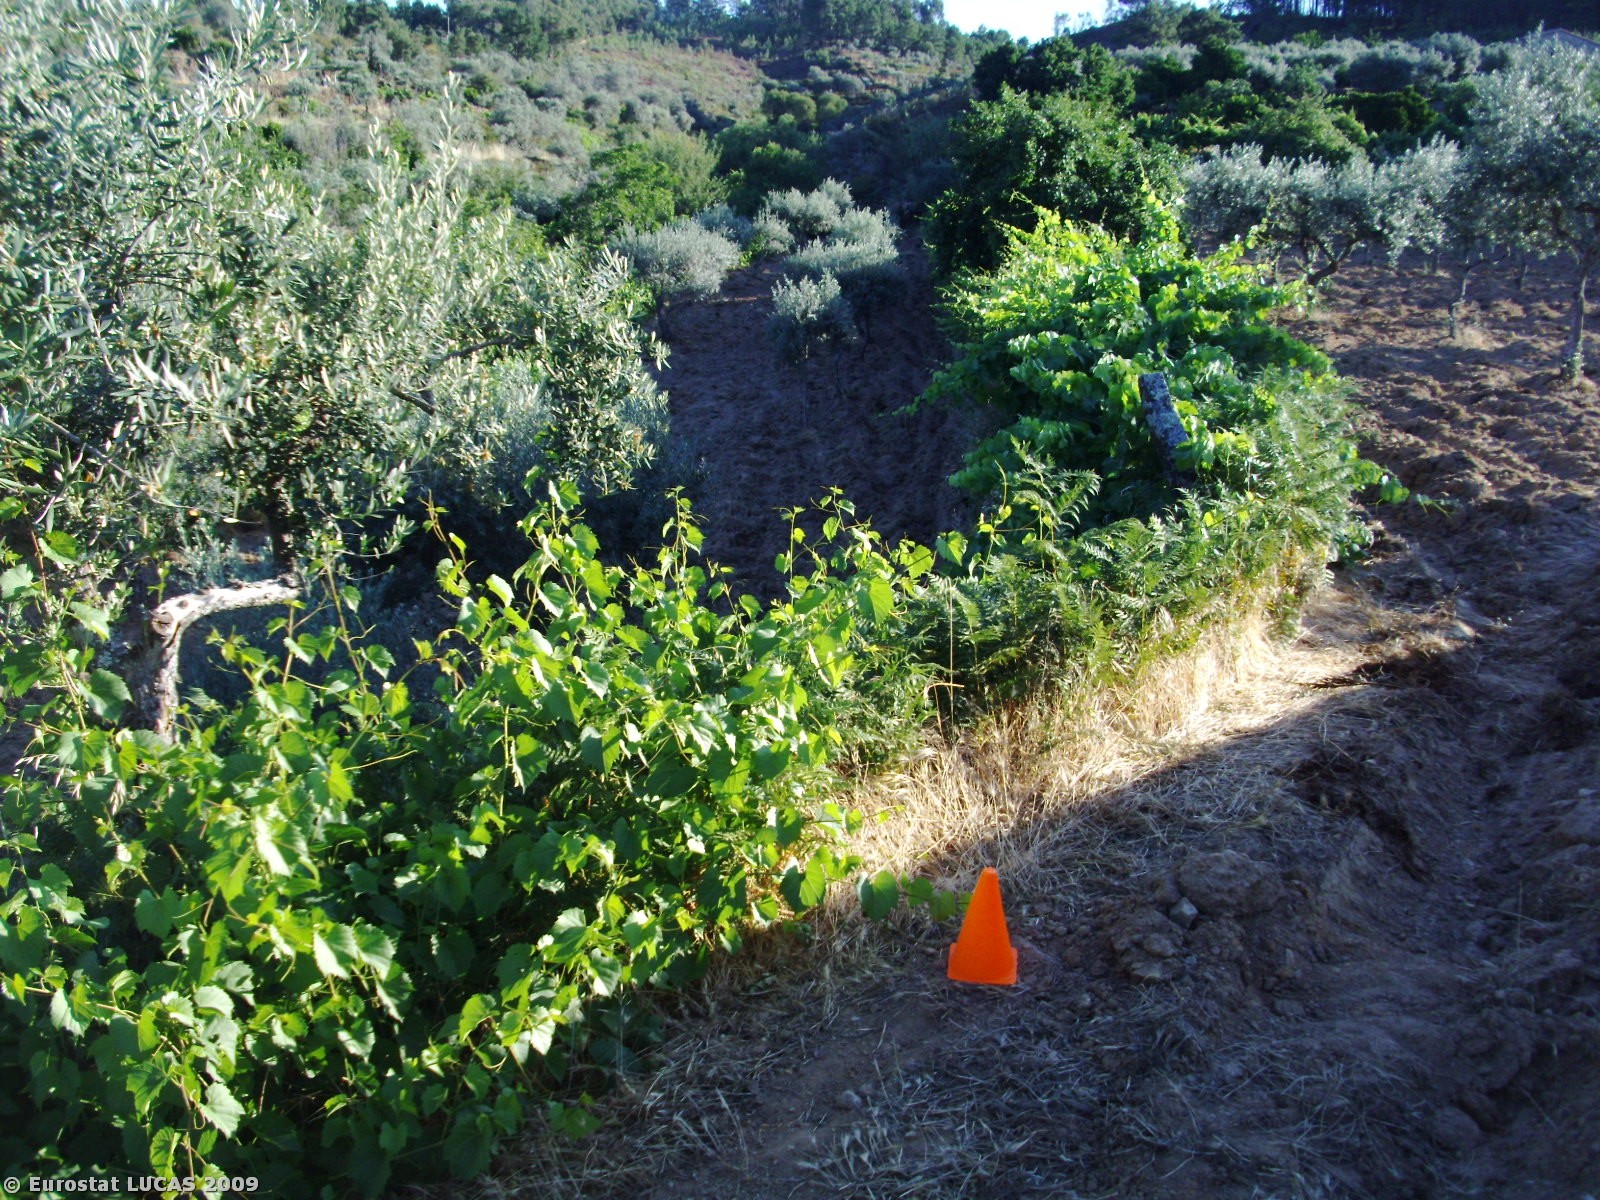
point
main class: Cropland
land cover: Olive groves
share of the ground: 50 - 75 %
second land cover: Vineyards
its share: 10 - 25 %
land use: Agriculture (excluding fallow land and kitchen gardens)
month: June
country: PT
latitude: 40.0366
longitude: -7.5547
